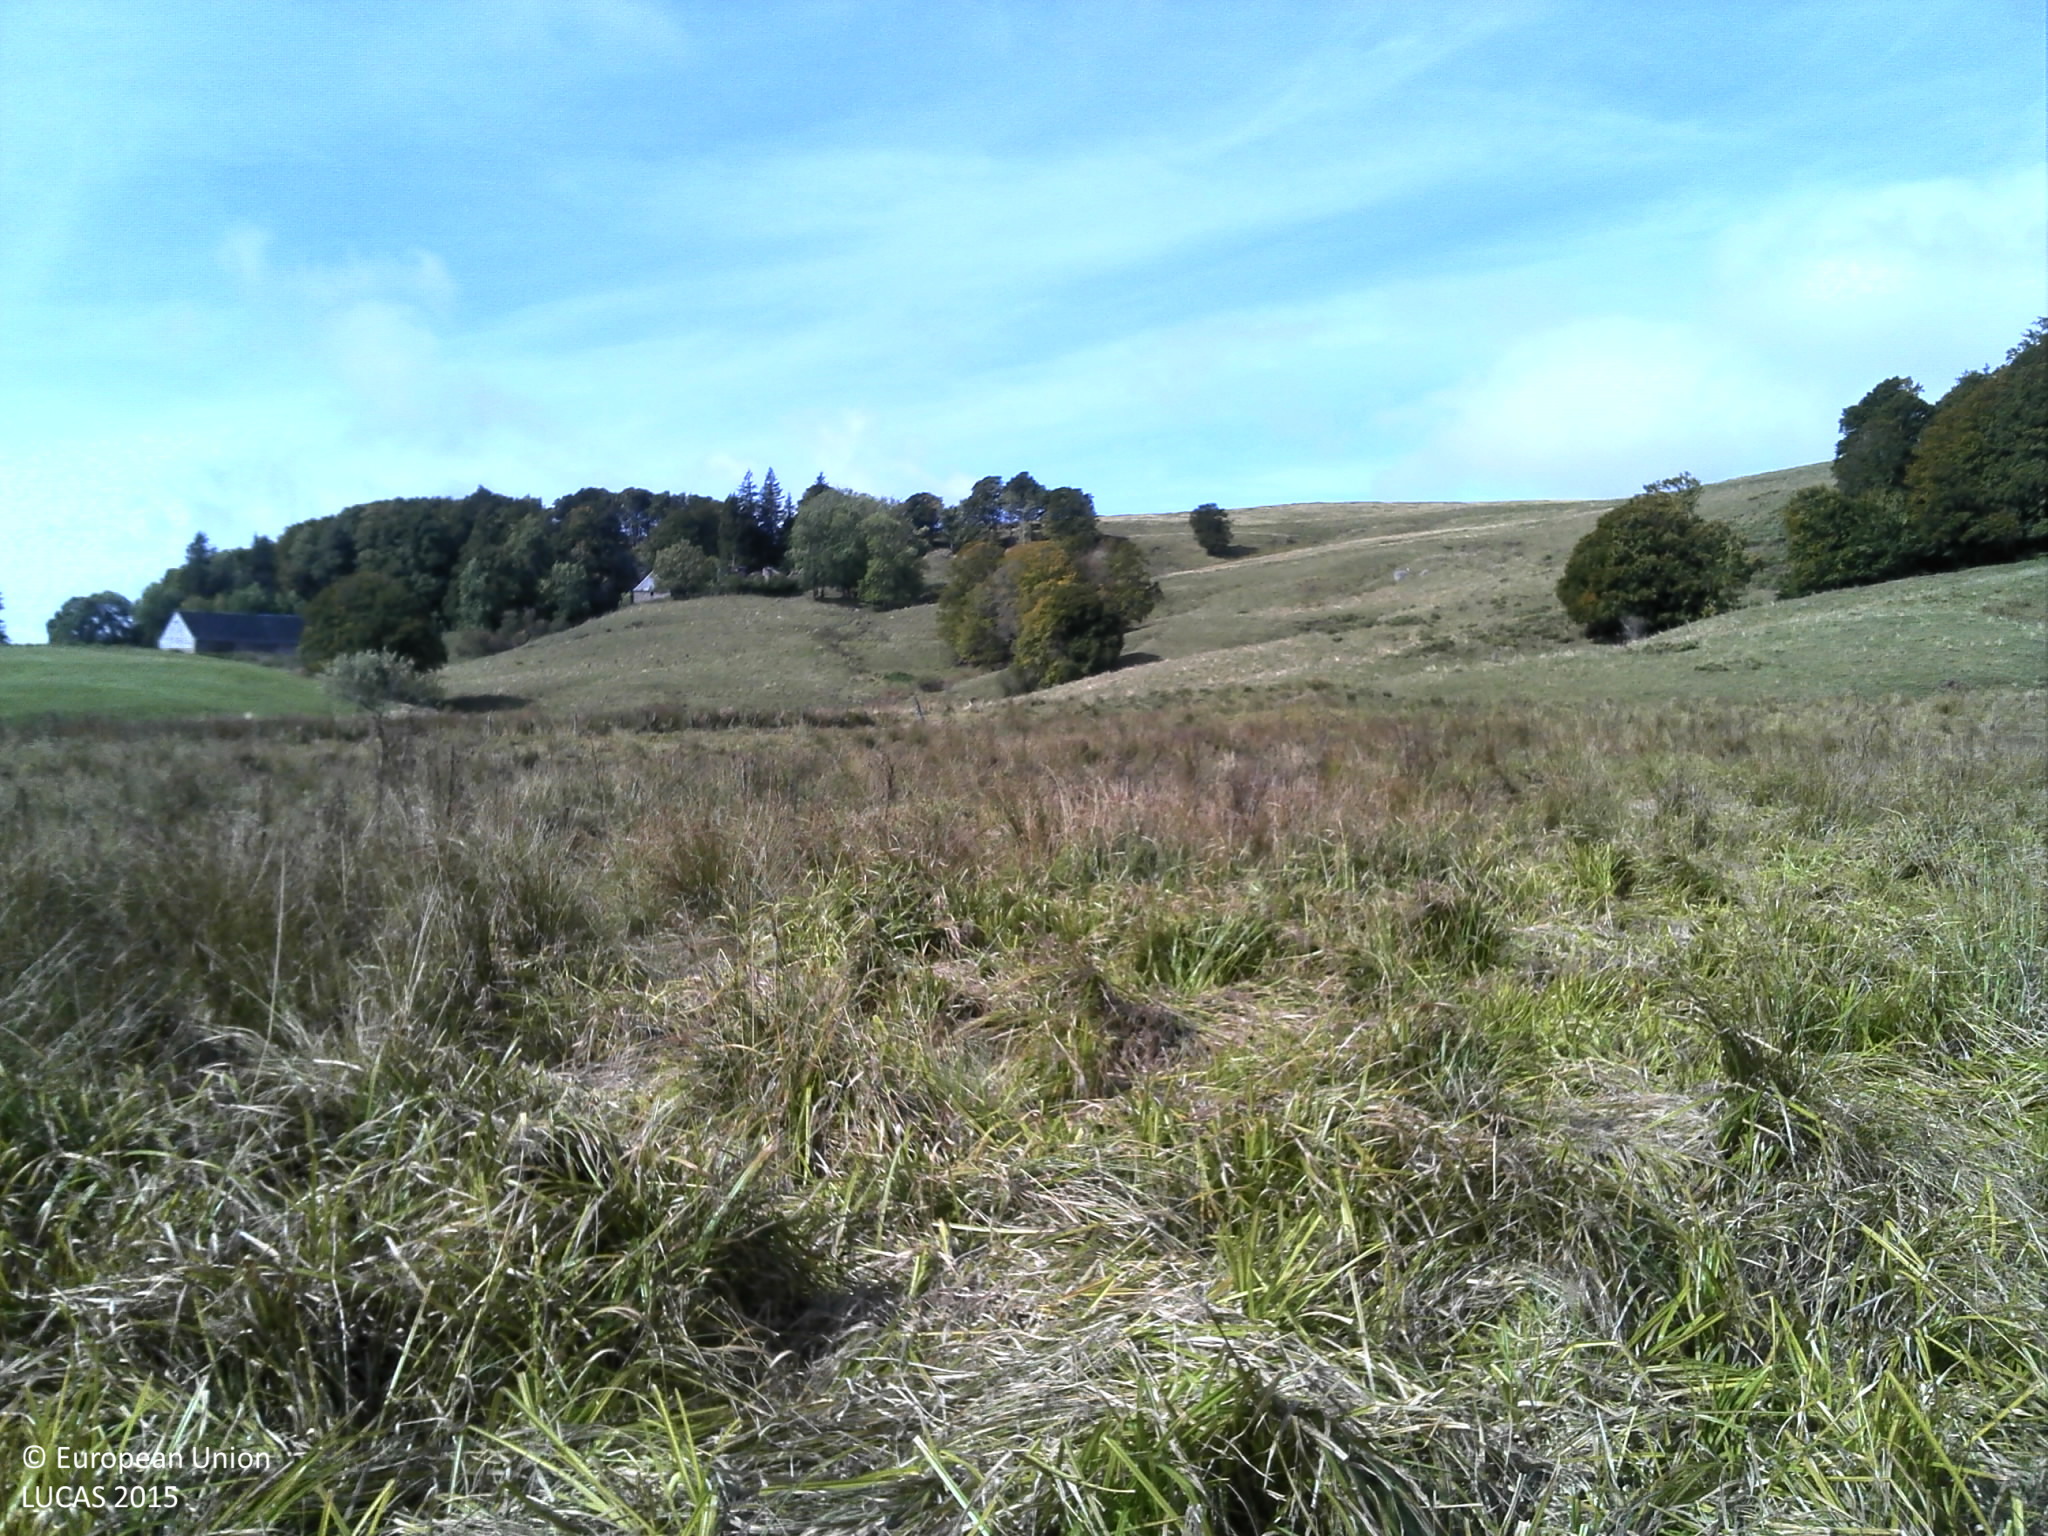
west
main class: Grassland
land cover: Grassland without tree/shrub cover
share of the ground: > 75 %
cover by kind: herbaceous plants 100 %
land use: Agriculture (excluding fallow land and kitchen gardens)
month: September
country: FR
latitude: 45.4984
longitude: 2.8718
